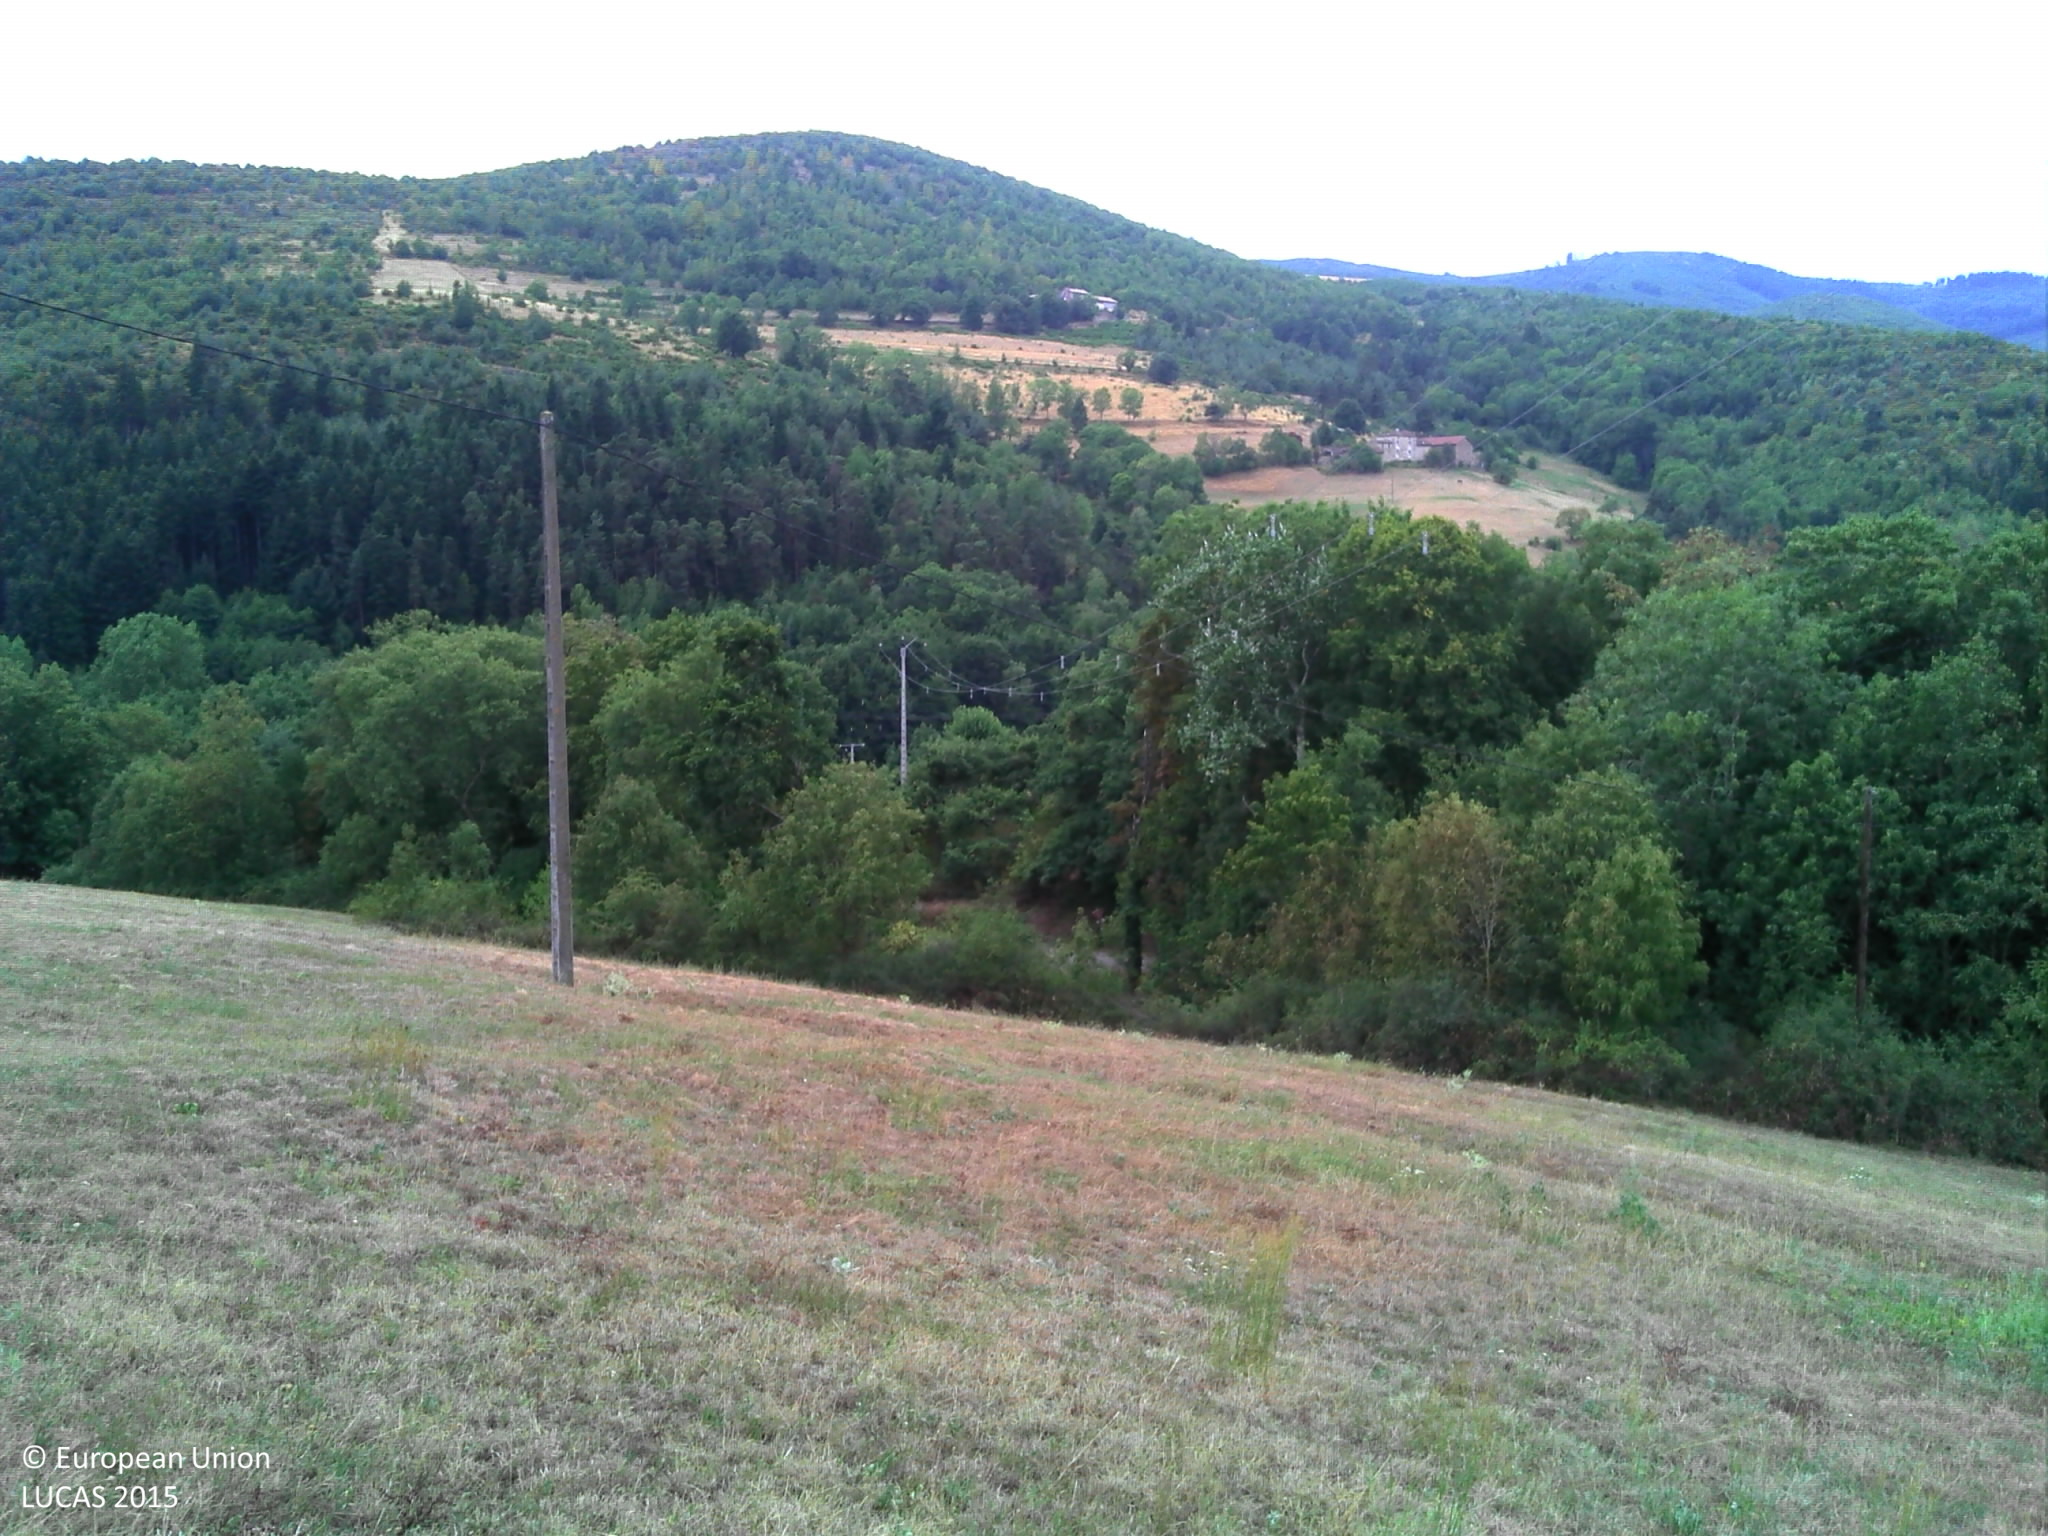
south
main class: Grassland
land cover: Grassland without tree/shrub cover
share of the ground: > 75 %
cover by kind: herbaceous plants 85 %, unconsolidated bare surface 15 %
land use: Agriculture (excluding fallow land and kitchen gardens)
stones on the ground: 10 - 25 %
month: August
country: FR
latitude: 45.2945
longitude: 4.6107
